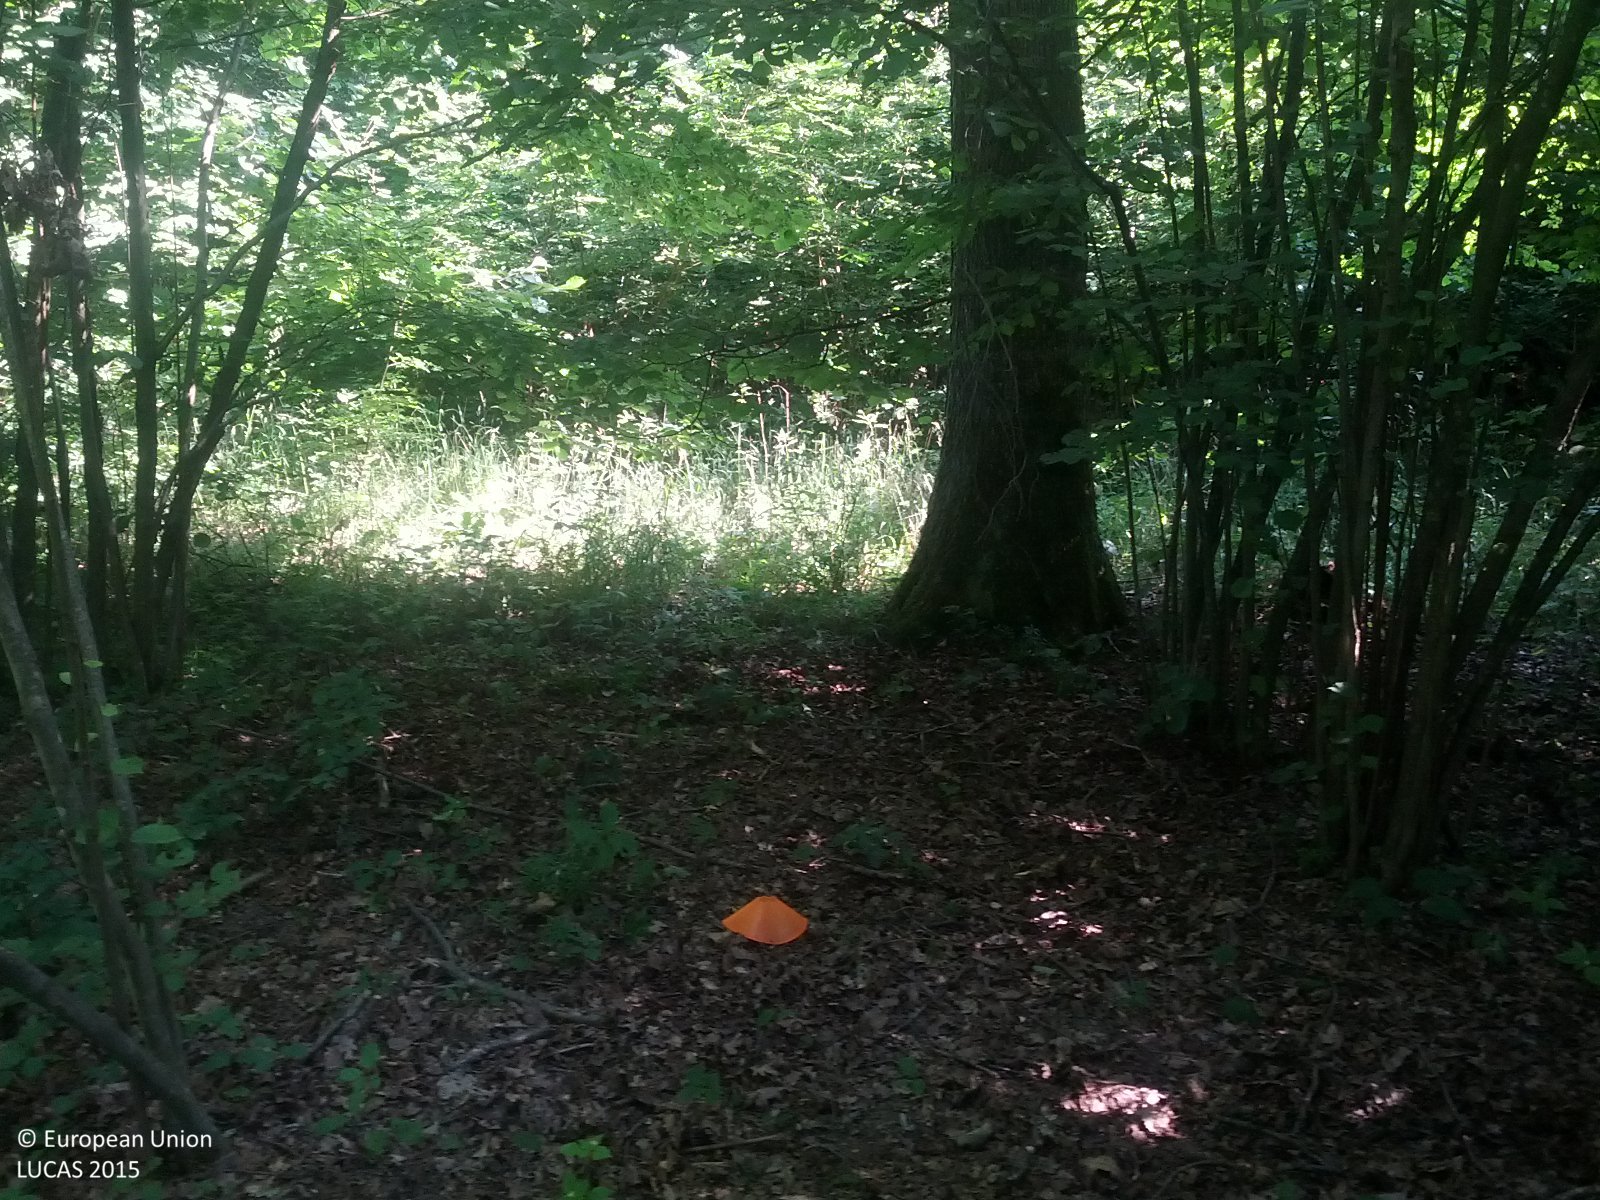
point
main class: Woodland
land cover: Broadleaved woodland
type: beech forest
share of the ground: > 75 %
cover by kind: broadleaved forest trees 90 %, shrubs 5 %, herbaceous plants 5 %
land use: Forestry
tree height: > 5 m
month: July
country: AT
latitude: 48.5694
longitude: 16.2528
